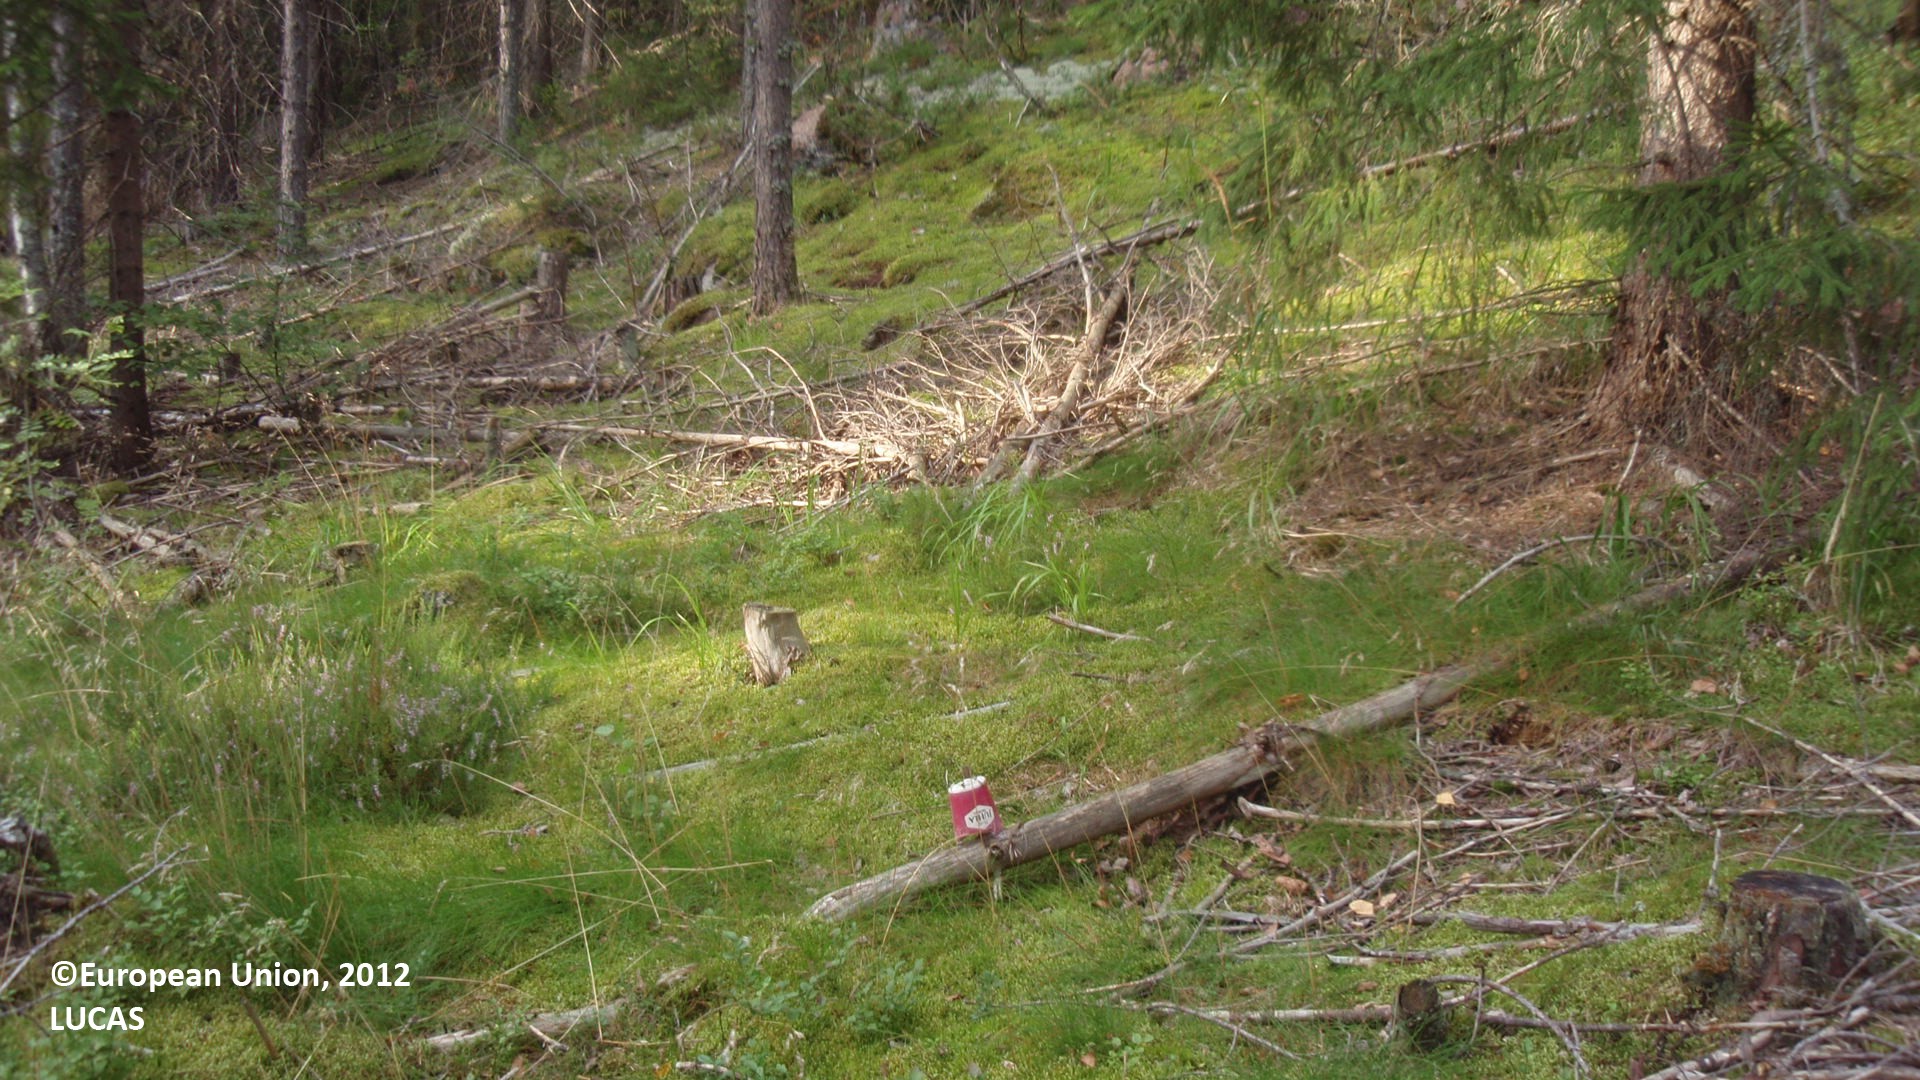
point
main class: Woodland
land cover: Pine dominated mixed woodland
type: boreal forest
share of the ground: 50 - 75 %
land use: Forestry
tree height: > 5 m
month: August
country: FI
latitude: 60.7248
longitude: 27.1684
